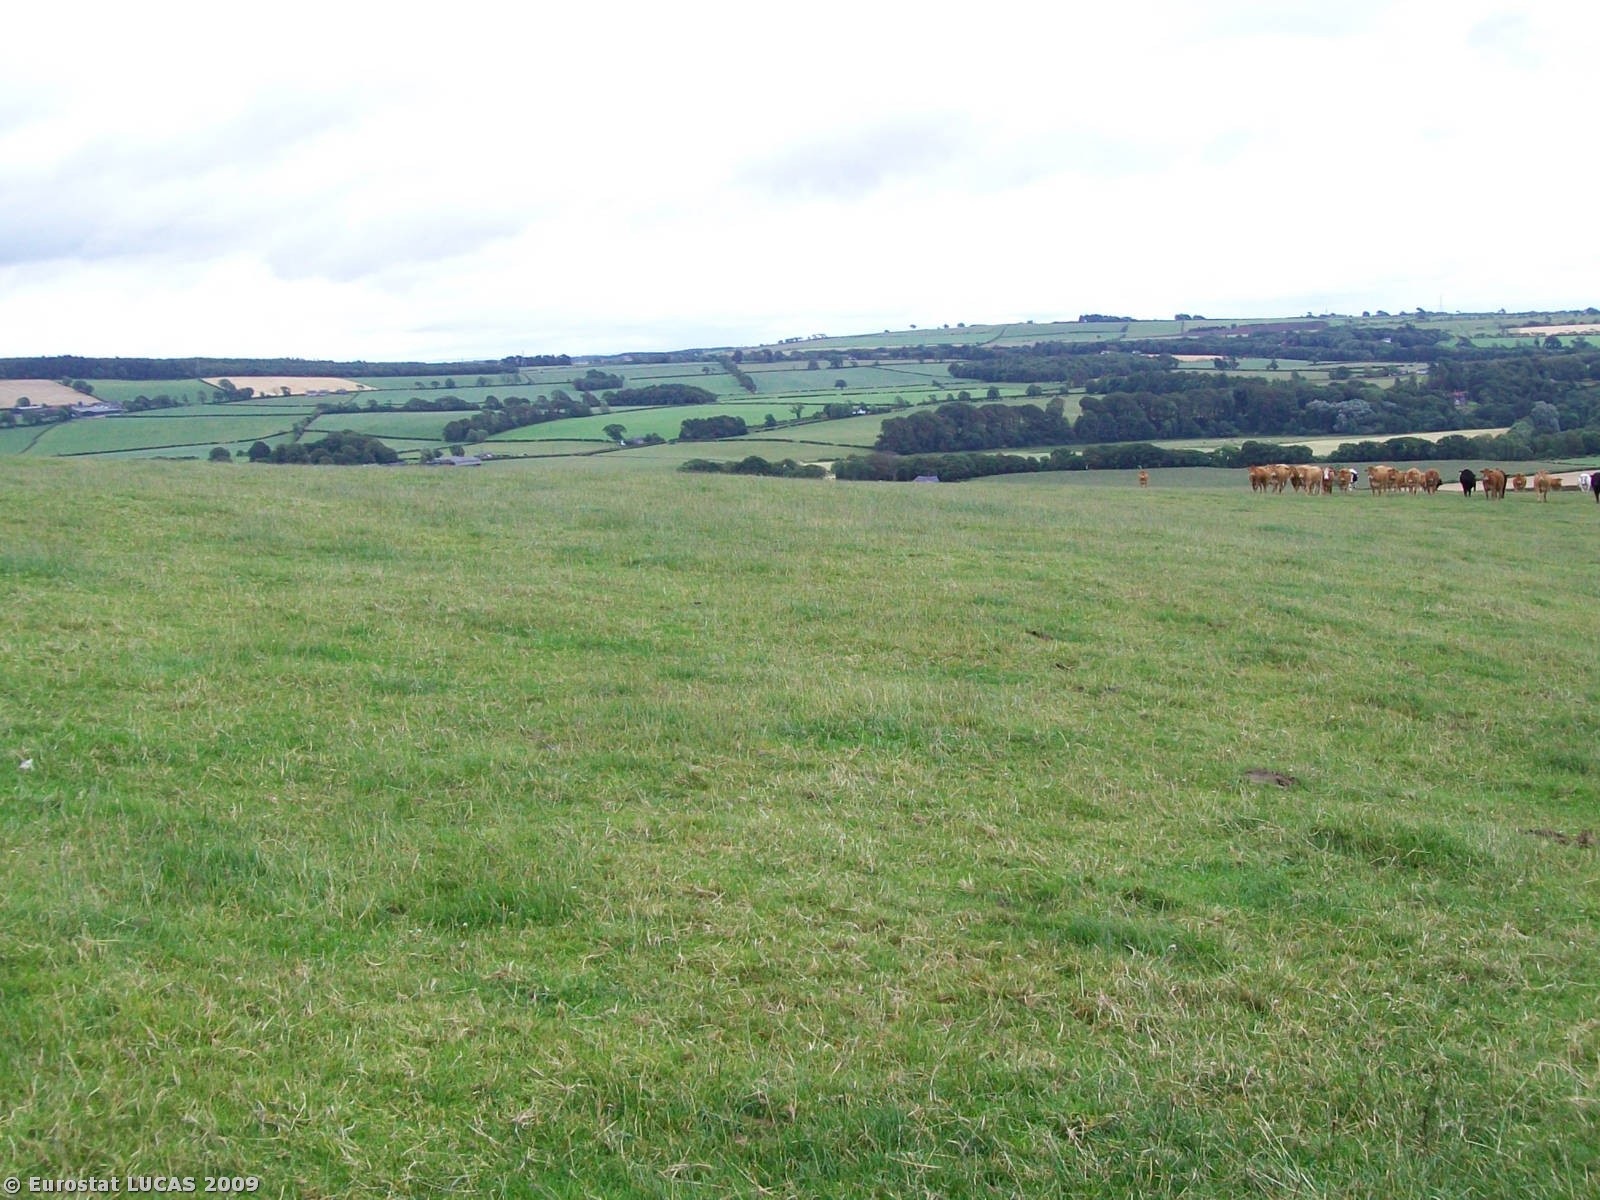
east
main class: Grassland
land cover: Grassland without tree/shrub cover
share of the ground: > 75 %
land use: Agriculture (excluding fallow land and kitchen gardens)
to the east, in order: Grassland without tree/shrub cover
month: July
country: GB
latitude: 55.0353
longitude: -3.2981
